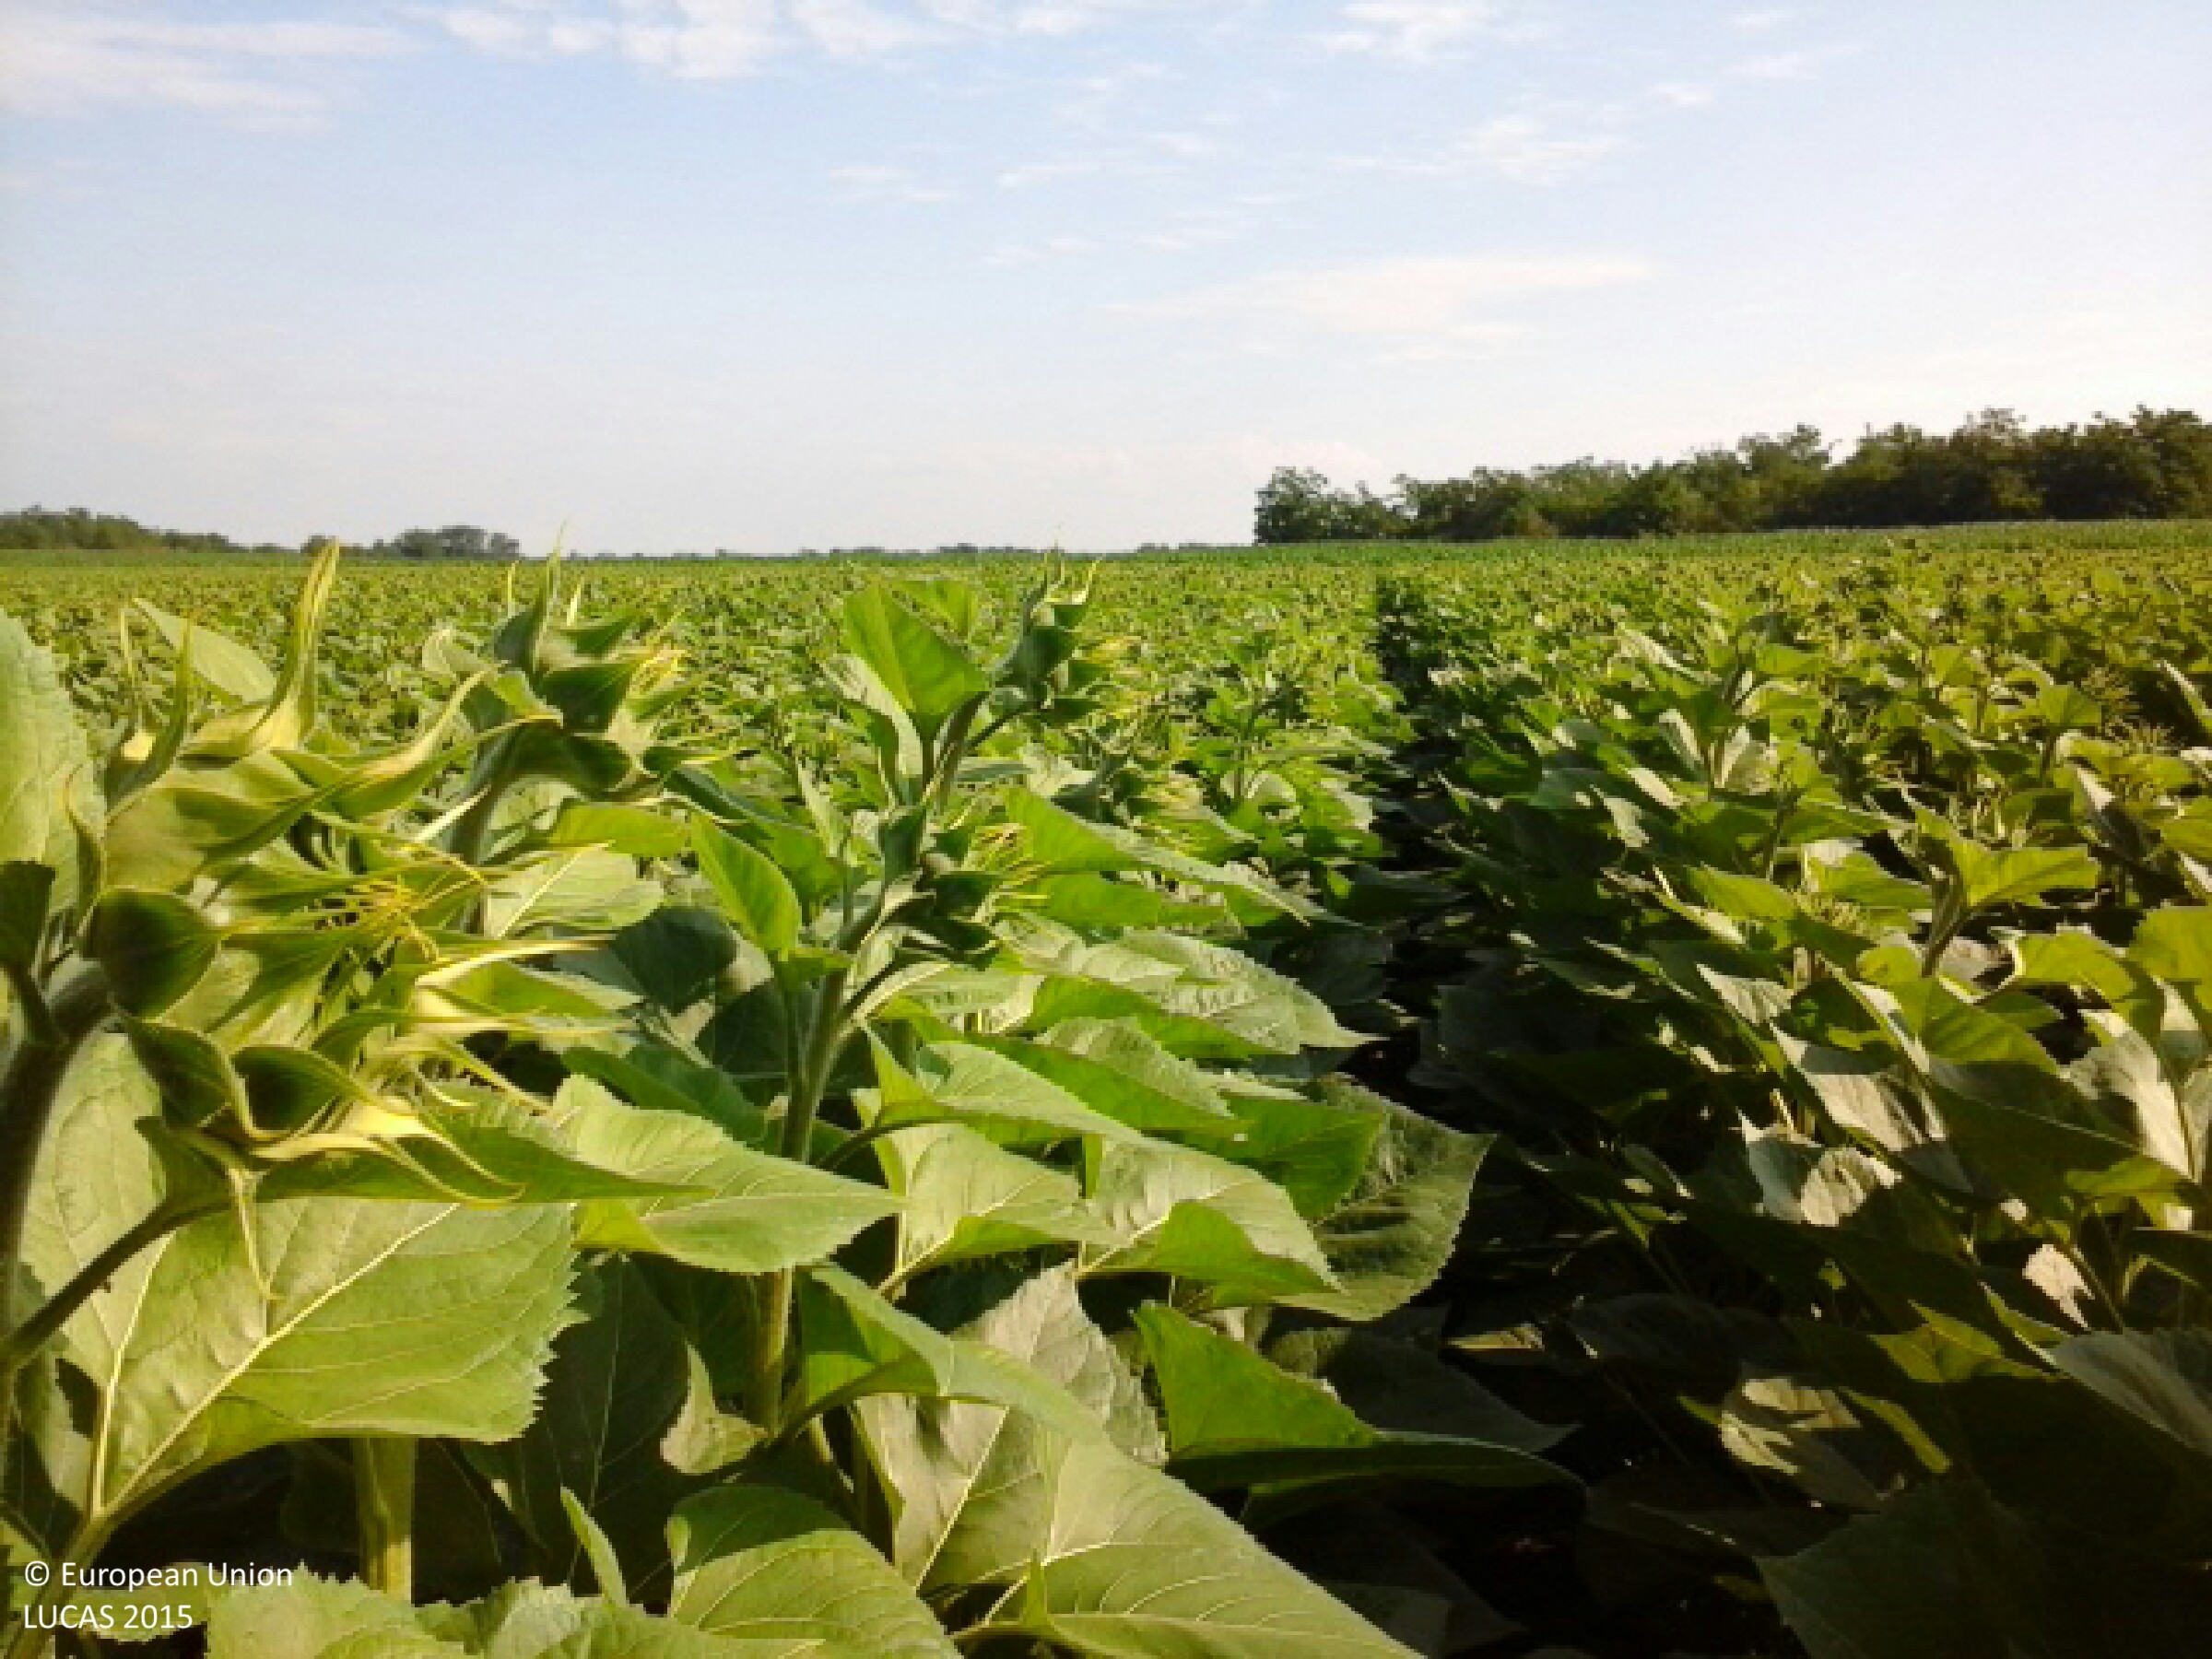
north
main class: Cropland
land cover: Sunflower
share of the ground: > 75 %
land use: Agriculture (excluding fallow land and kitchen gardens)
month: June
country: HU
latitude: 48.0334
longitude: 21.5392
